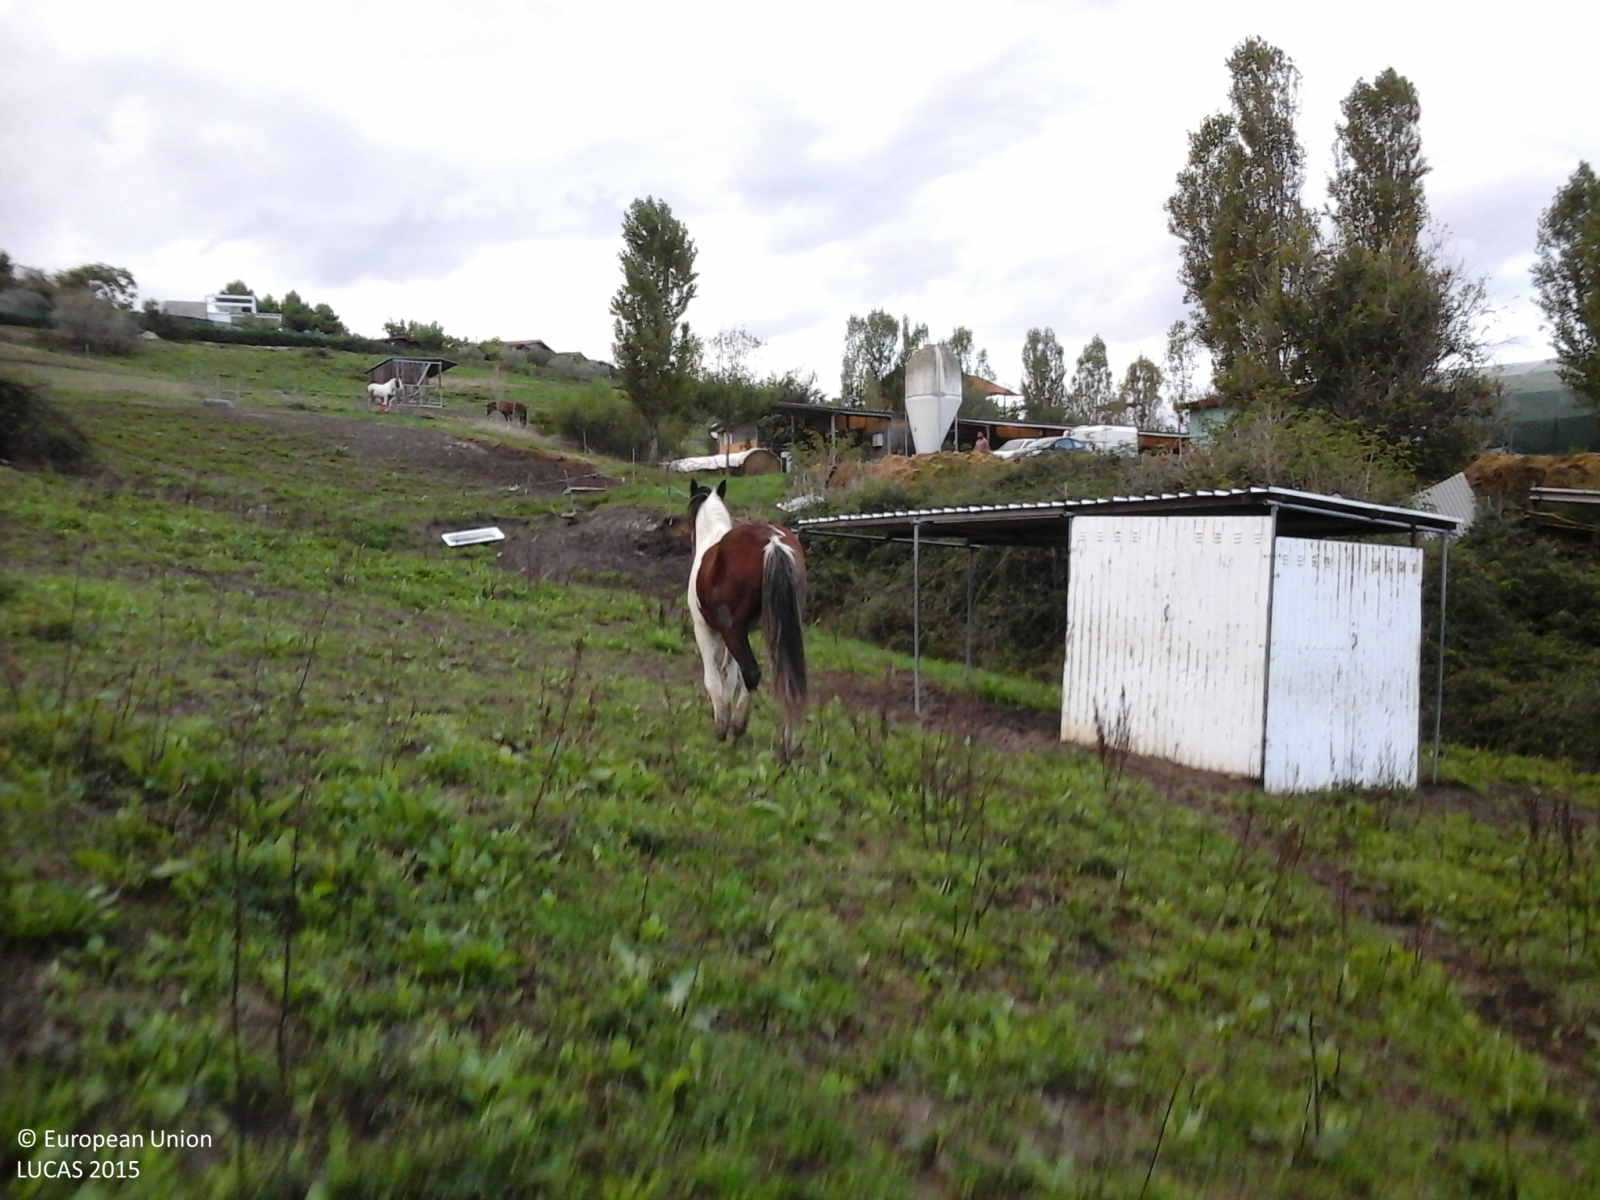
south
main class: Grassland
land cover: Grassland without tree/shrub cover
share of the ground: > 75 %
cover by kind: herbaceous plants 100 %
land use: Agriculture (excluding fallow land and kitchen gardens)
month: October
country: IT
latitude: 43.6088
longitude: 13.3991
